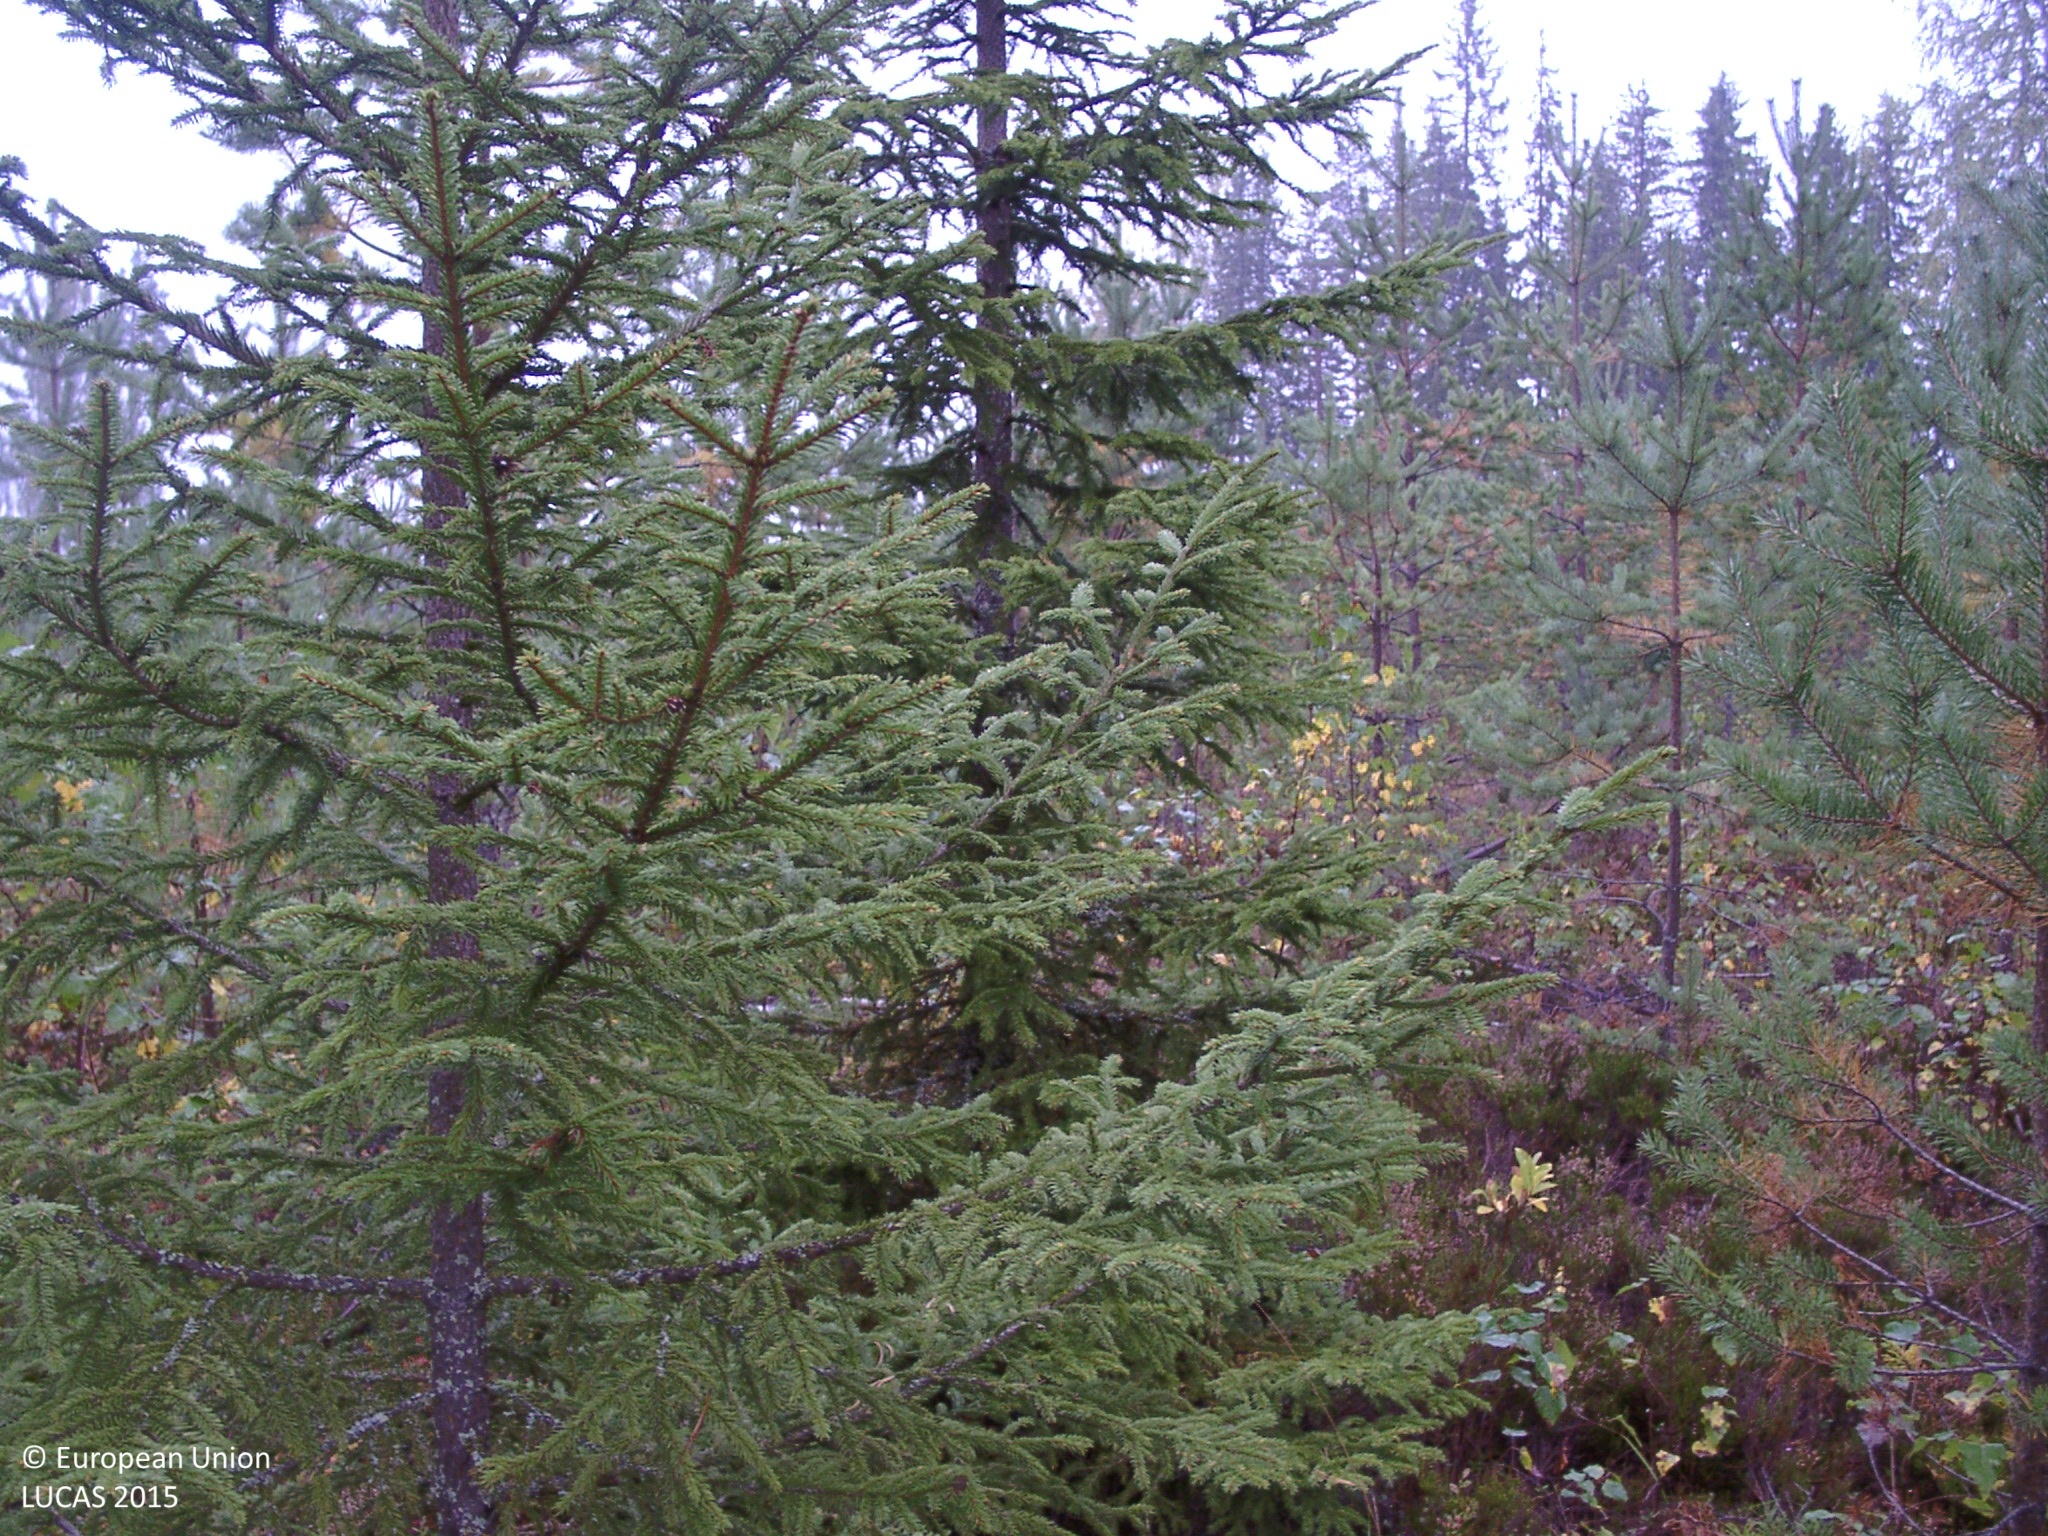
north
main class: Woodland
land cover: Pine dominated mixed woodland
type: boreal forest
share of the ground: 25 - 50 %
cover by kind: shrubs 35 %, coniferous forest trees 30 %, broadleaved forest trees 15 %, lichens and mosses 15 %, herbaceous plants 5 %
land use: Forestry
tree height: < 5 m
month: September
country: FI
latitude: 62.7086
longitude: 25.6550
